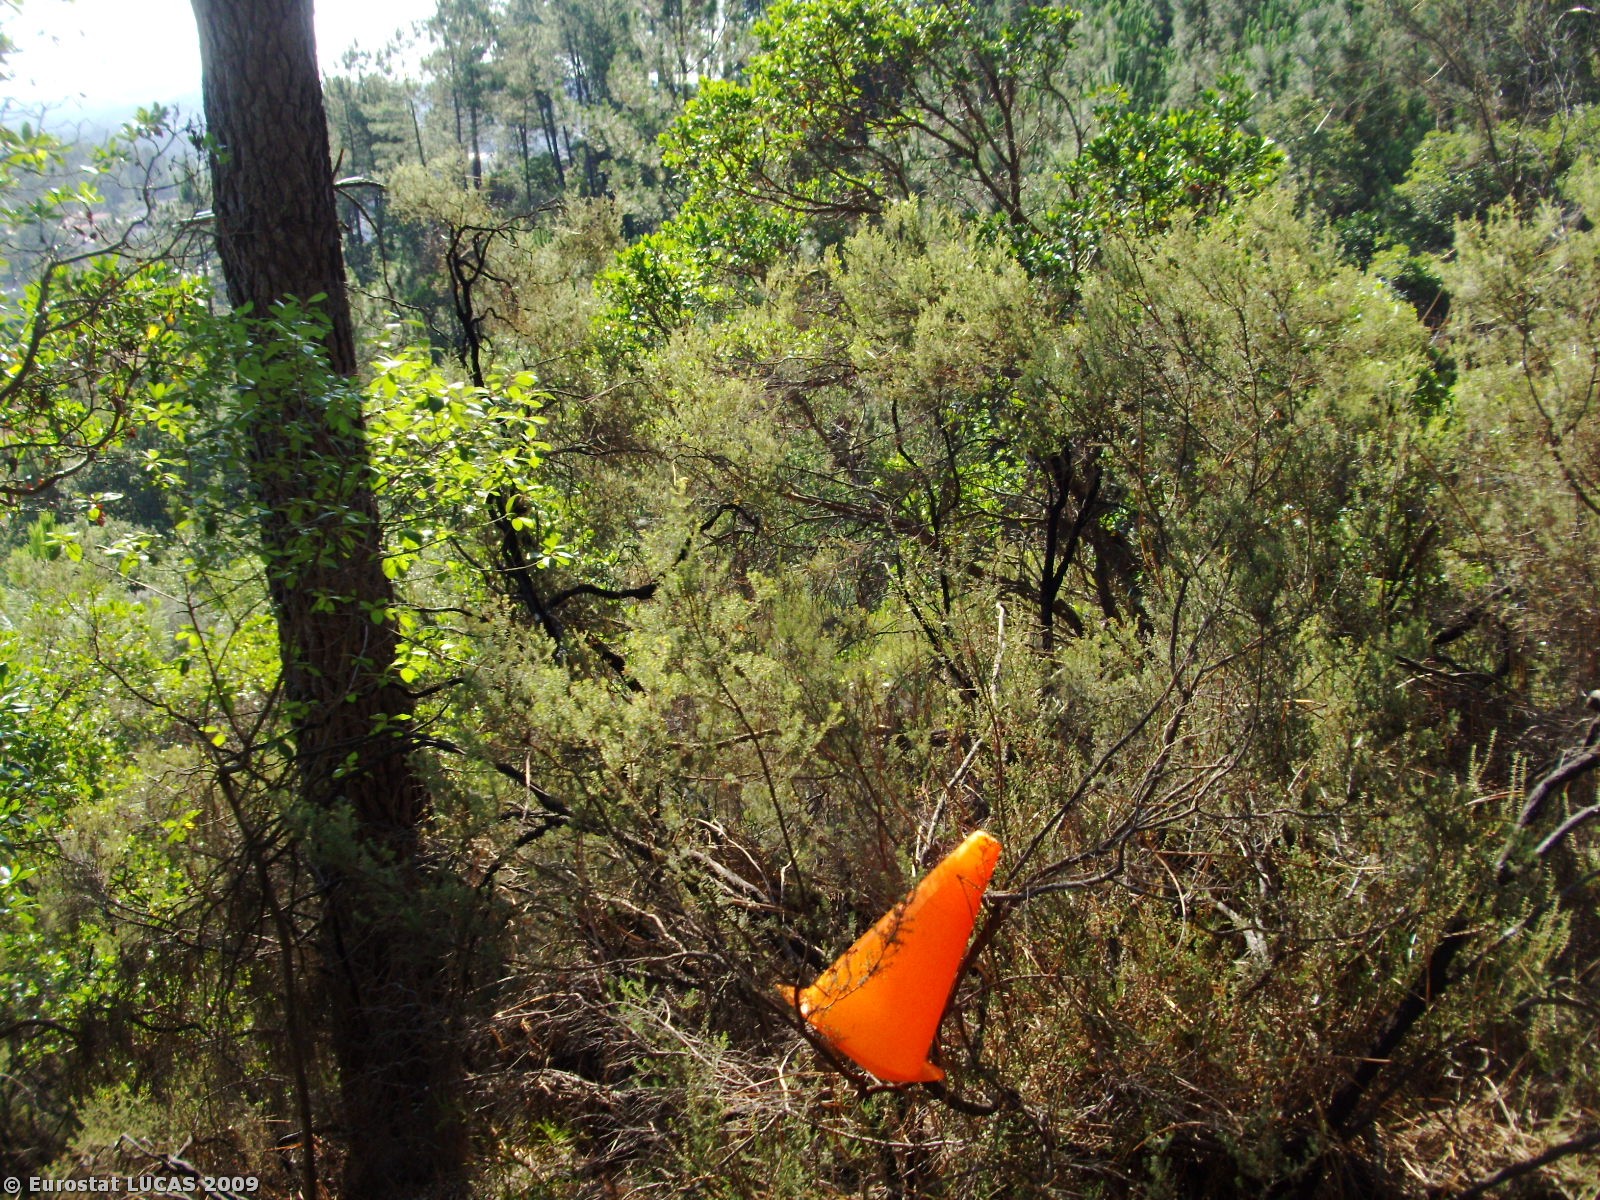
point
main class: Woodland
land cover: Coniferous woodland
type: coniferous forest of the mediterranean region
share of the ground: > 75 %
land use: Forestry
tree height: > 5 m
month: August
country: PT
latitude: 39.8039
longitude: -8.1132
